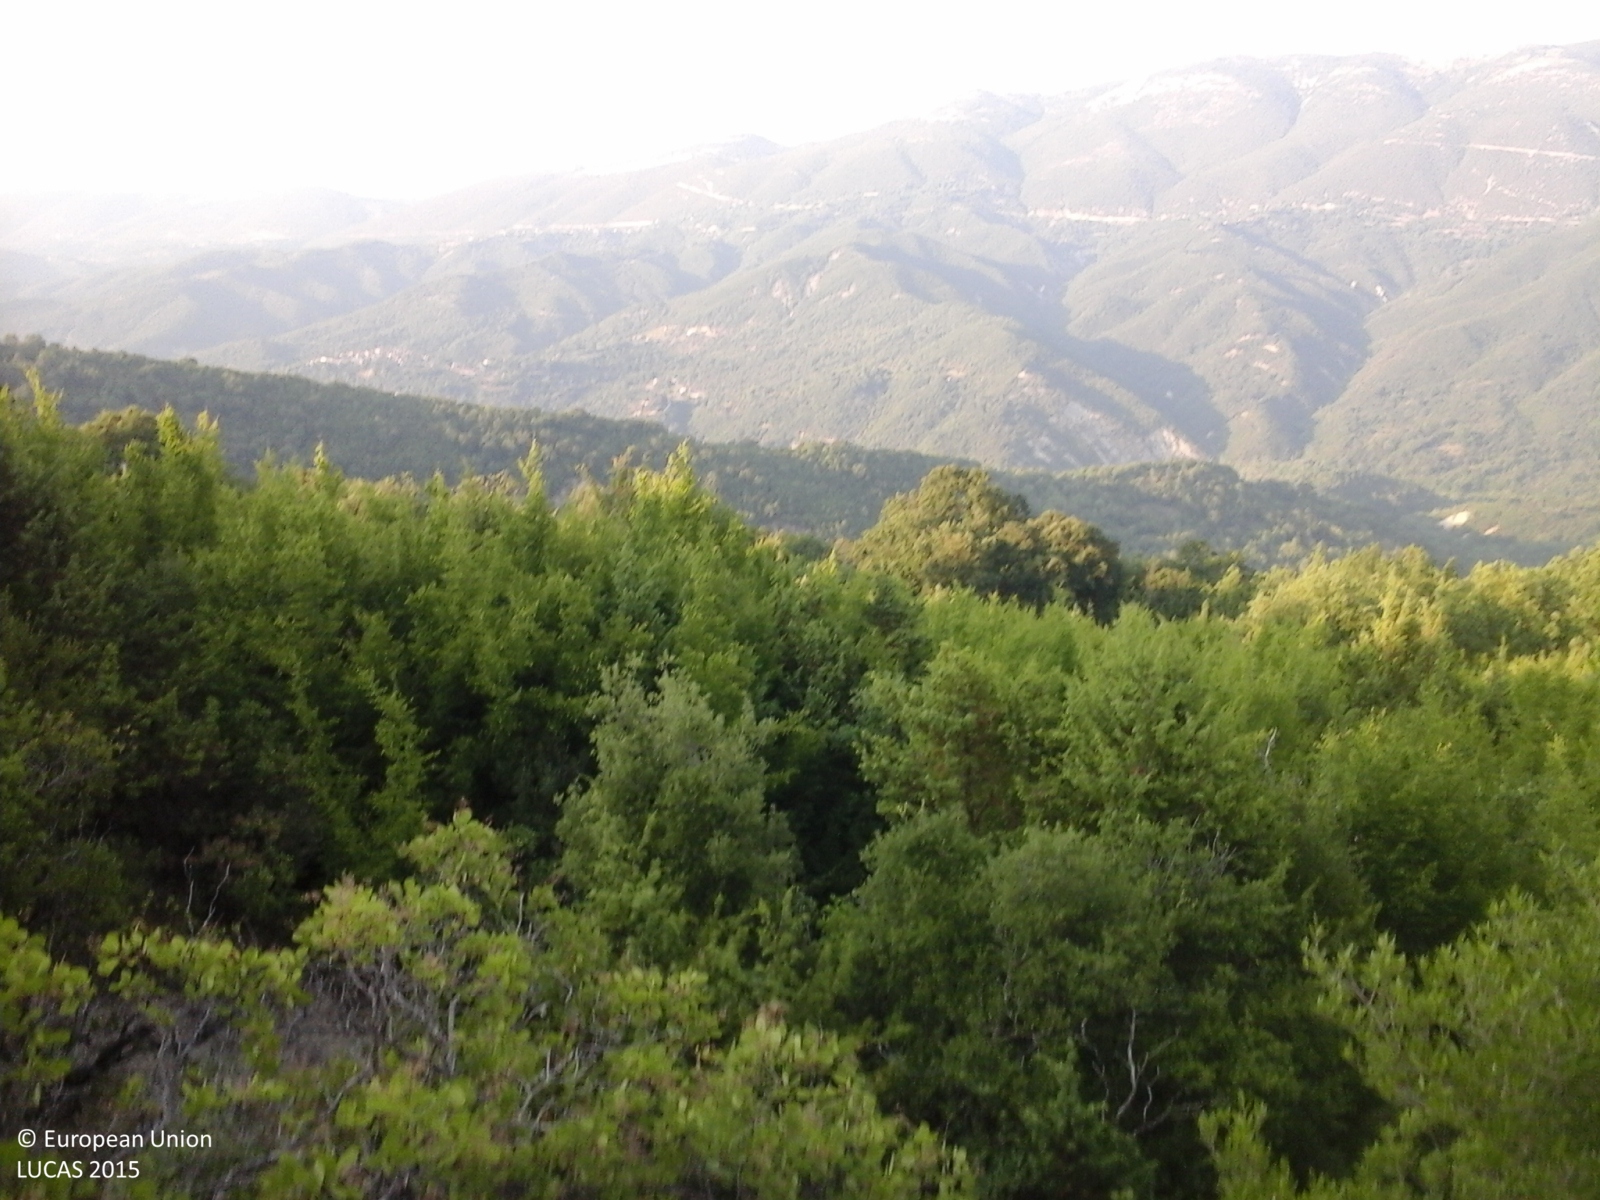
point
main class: Woodland
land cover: Other mixed woodland
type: thermophilous deciduous forest
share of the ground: > 75 %
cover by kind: broadleaved forest trees 55 %, herbaceous plants 25 %, coniferous forest trees 20 %
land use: Semi-natural and natural areas not in use
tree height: > 5 m
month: July
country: GR
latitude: 39.5814
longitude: 20.6059
